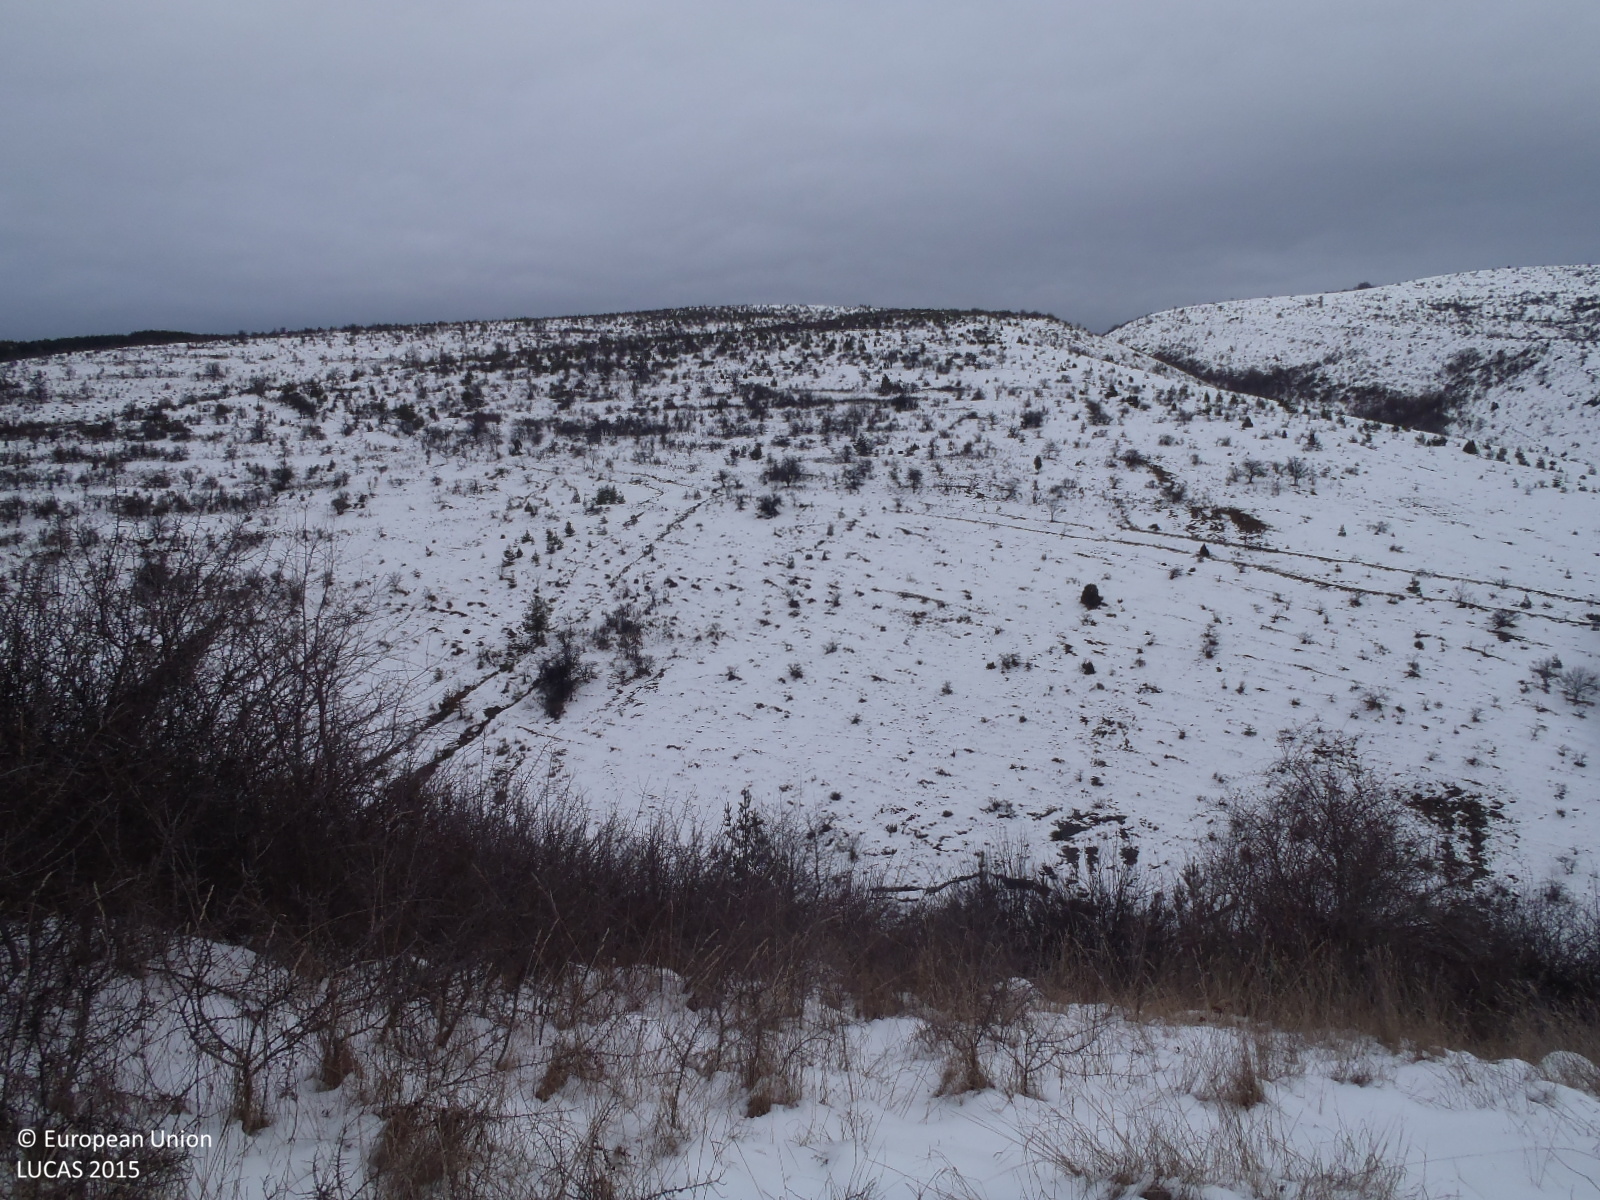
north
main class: Grassland
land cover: Grassland with sparse tree/shrub cover
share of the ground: > 75 %
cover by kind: herbaceous plants 85 %, shrubs 10 %, broadleaved forest trees 5 %
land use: Agriculture (excluding fallow land and kitchen gardens)
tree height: < 5 m
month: January
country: BG
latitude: 43.0853
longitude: 23.0425
